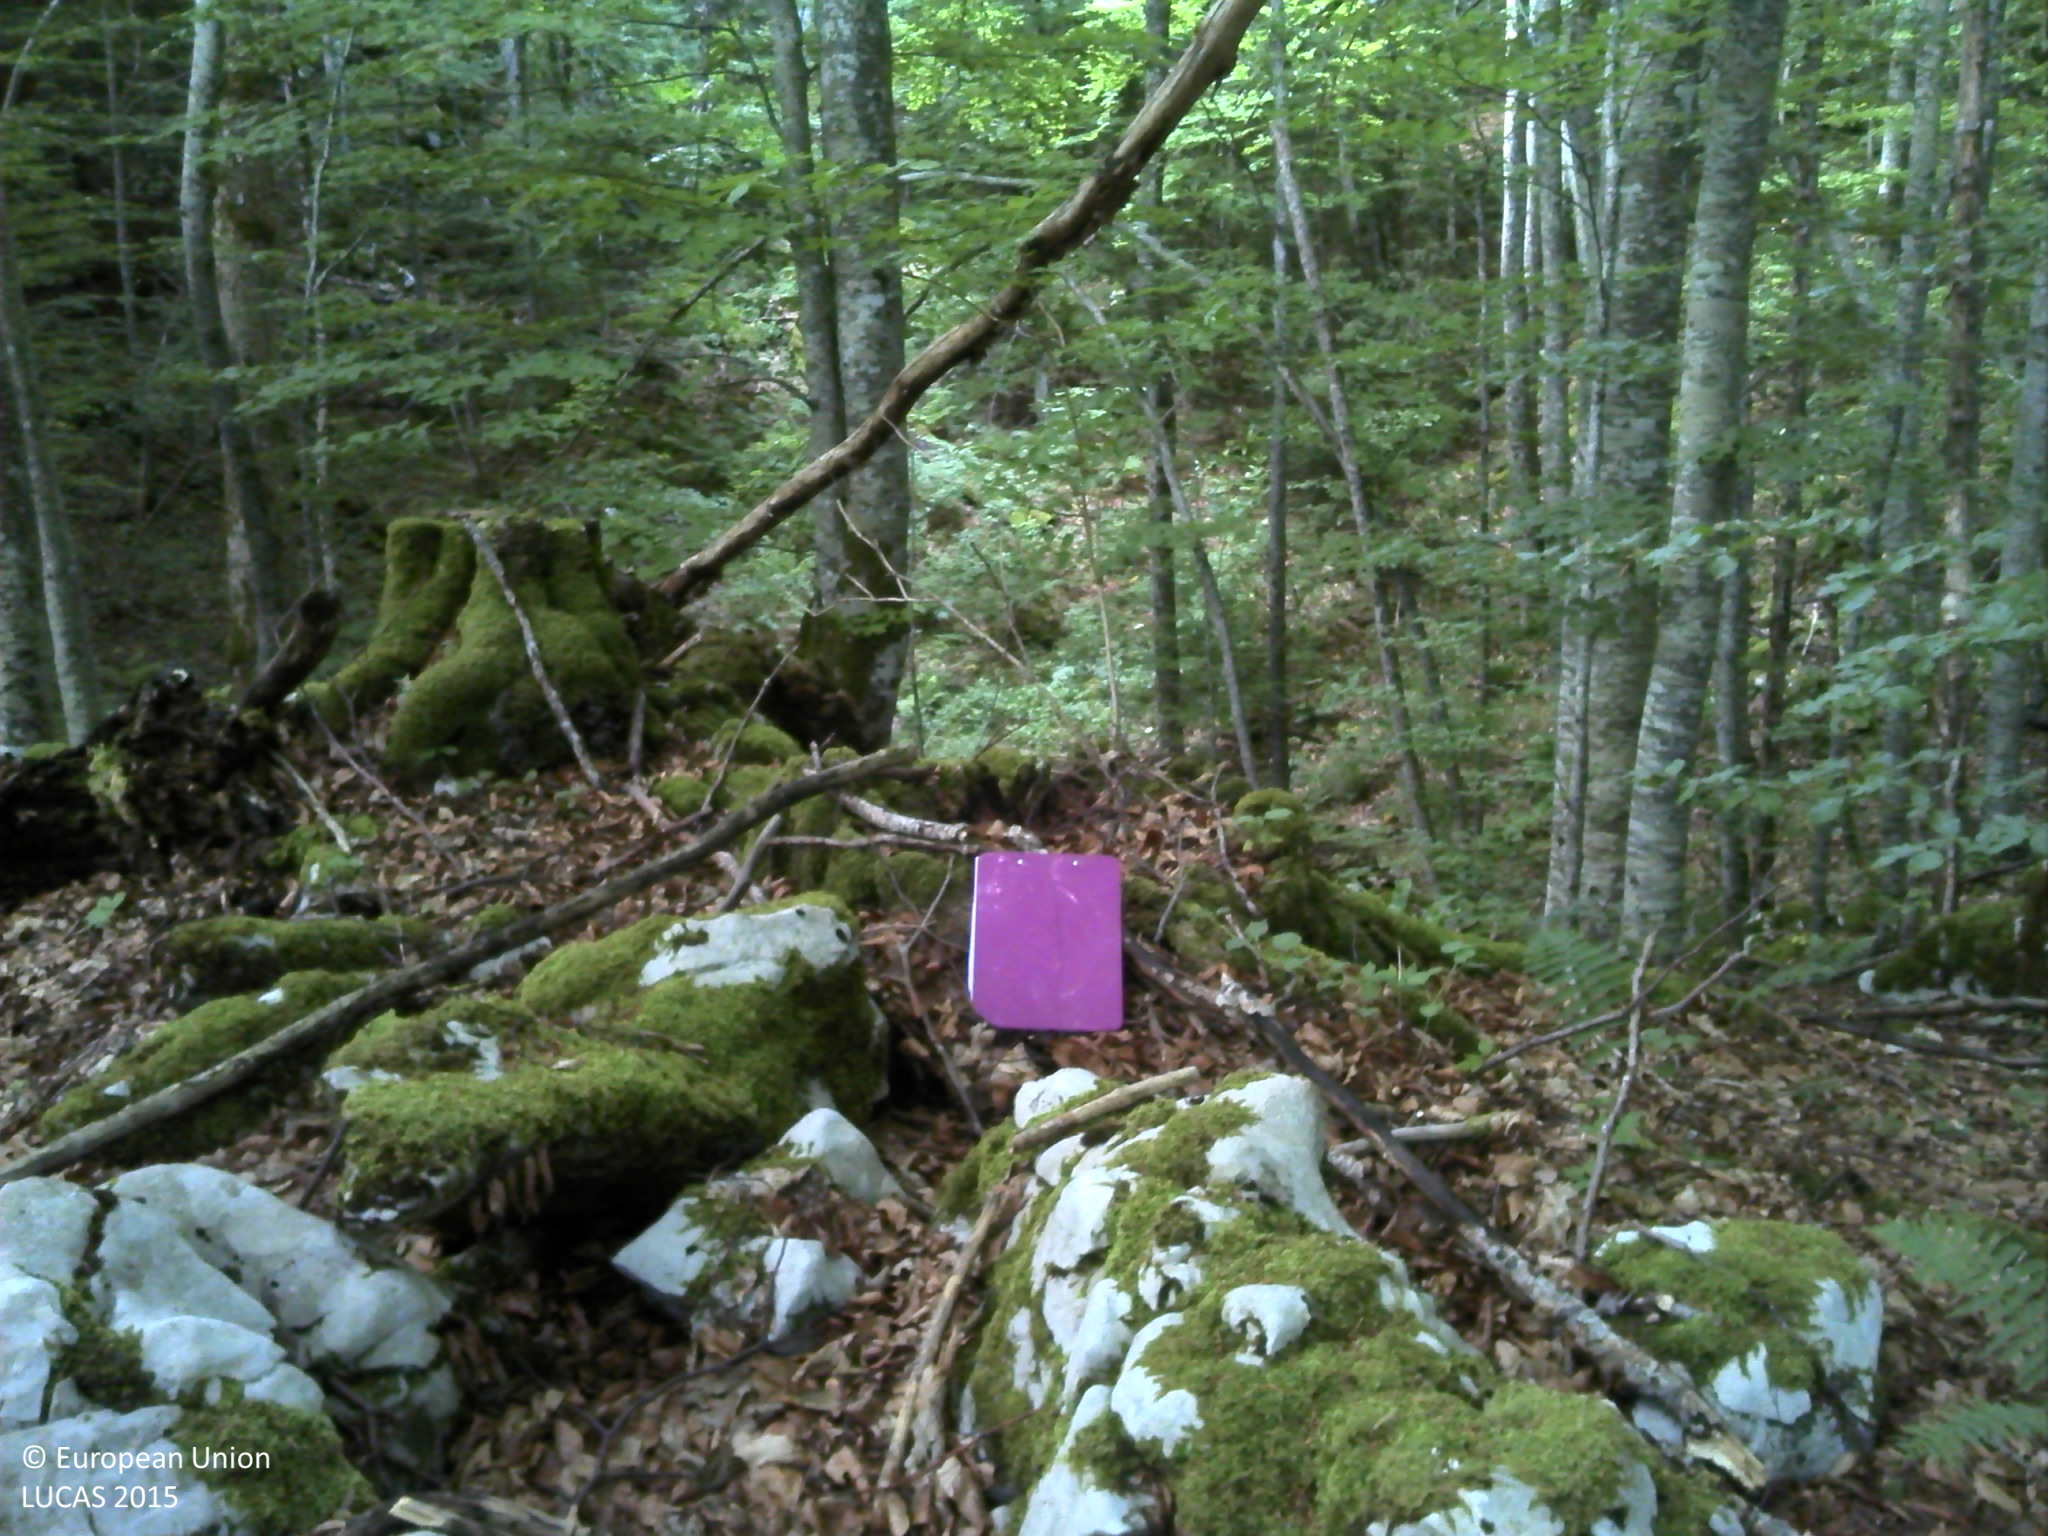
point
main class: Woodland
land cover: Broadleaved woodland
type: mountainous beech forest
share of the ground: > 75 %
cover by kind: broadleaved forest trees 90 %, consolidated bare surface 10 %
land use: Forestry
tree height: > 5 m
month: June
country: HR
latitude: 44.5983
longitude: 15.9026
